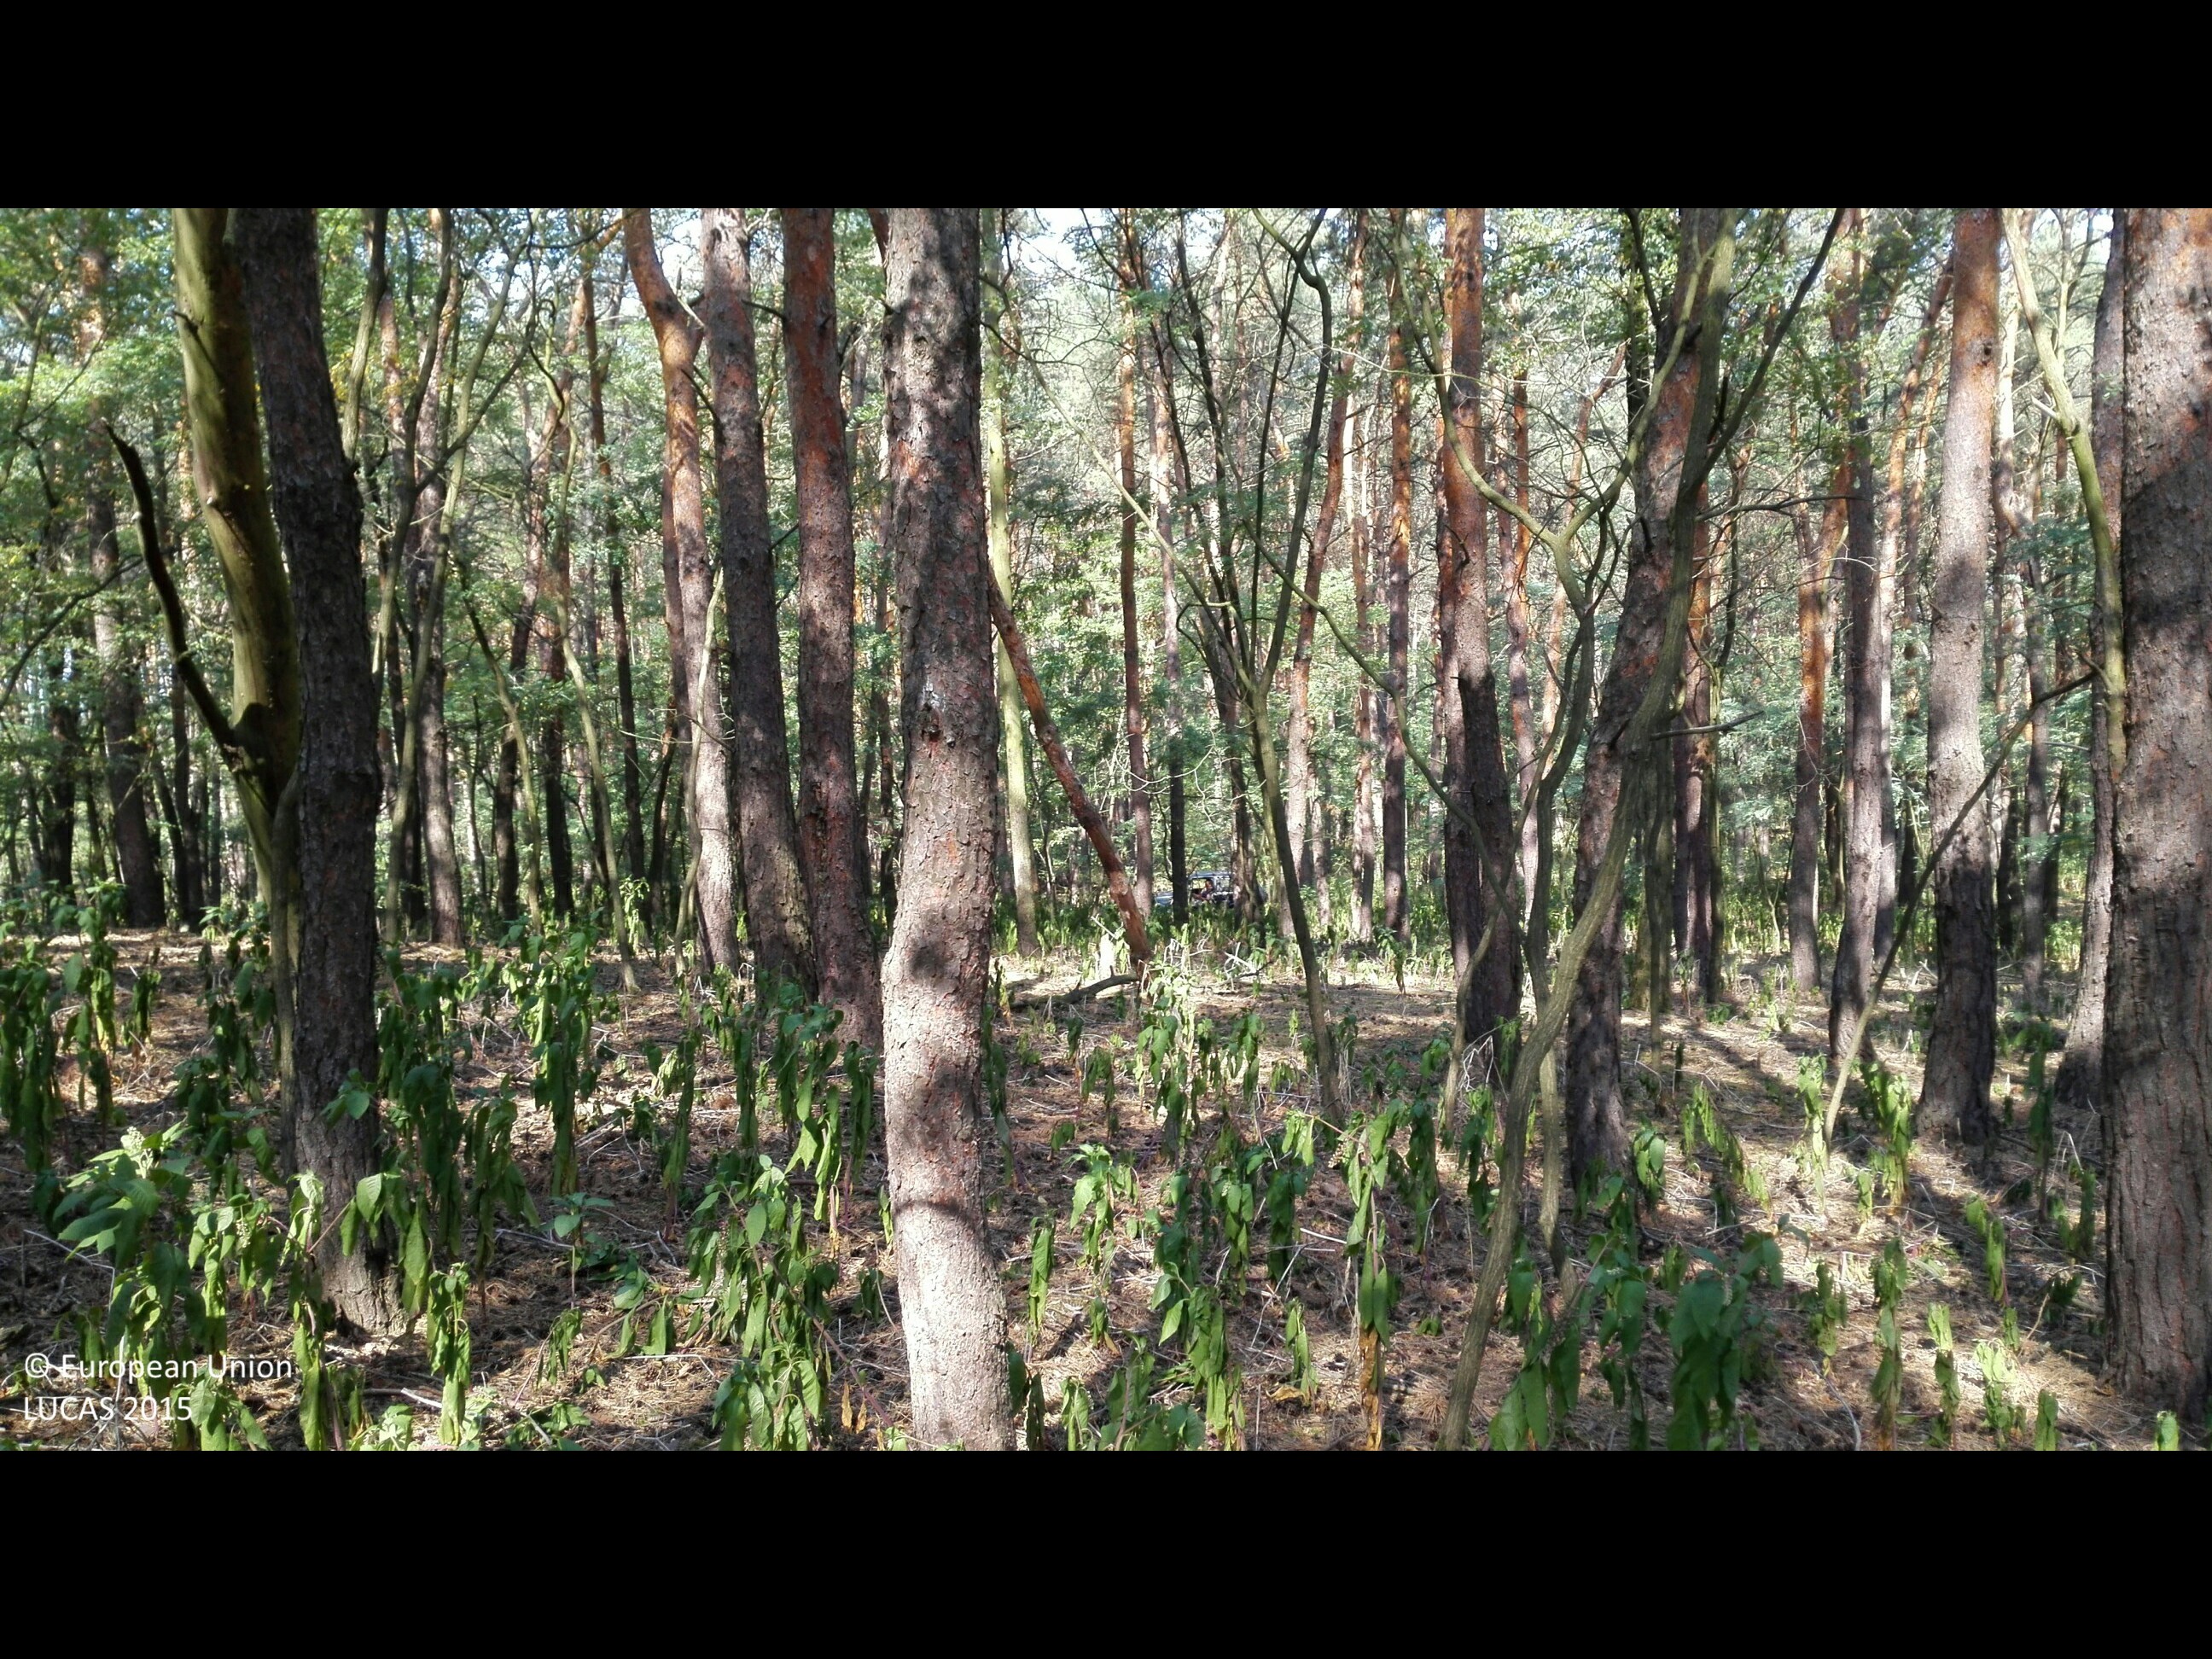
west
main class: Woodland
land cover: Pine dominated mixed woodland
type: hemiboreal forest and nemoral coniferous forest and mixed broadleaved-coniferous forest
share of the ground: > 75 %
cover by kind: coniferous forest trees 75 %, broadleaved forest trees 25 %
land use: Forestry
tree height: > 5 m
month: August
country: HU
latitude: 47.5947
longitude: 21.8981
